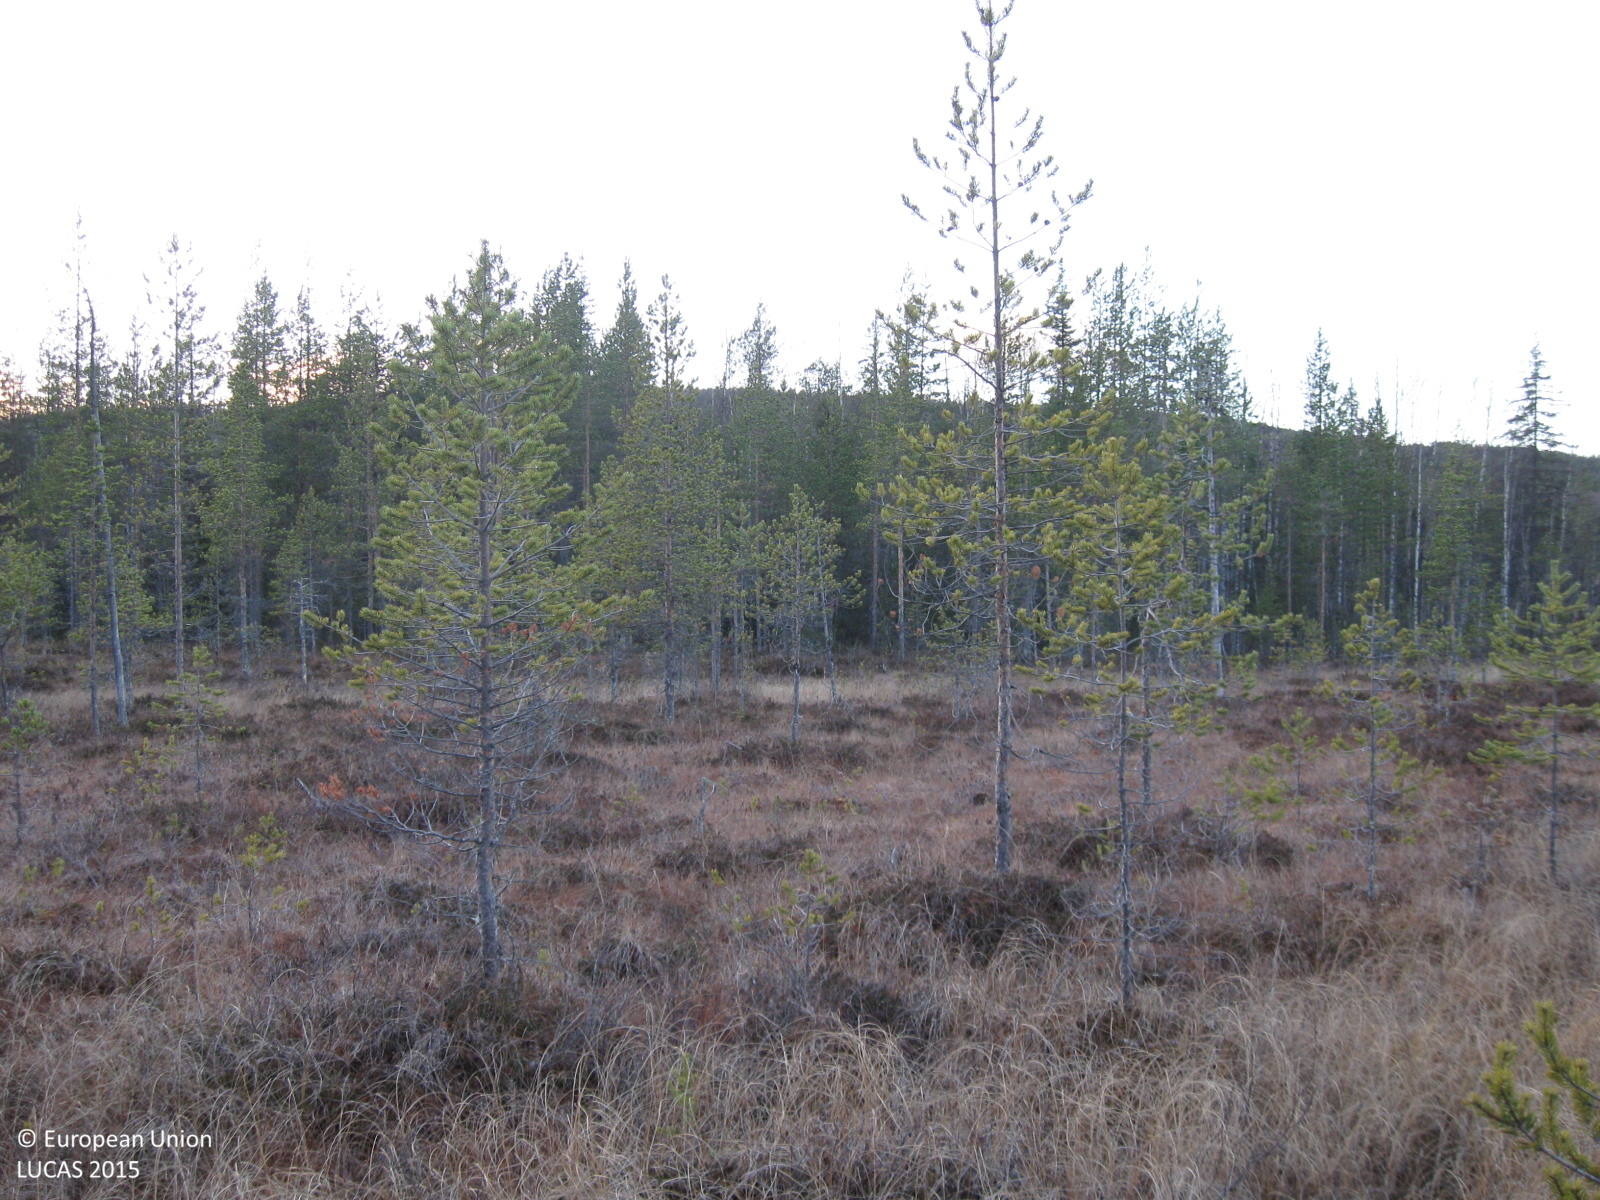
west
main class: Woodland
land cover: Pine dominated coniferous woodland
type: mire and swamp forests
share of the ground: 25 - 50 %
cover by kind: herbaceous plants 60 %, coniferous forest trees 25 %, shrubs 10 %, lichens and mosses 5 %
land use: Semi-natural and natural areas not in use
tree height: < 5 m
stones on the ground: < 10 %
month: November
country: SE
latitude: 66.1779
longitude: 20.6329
